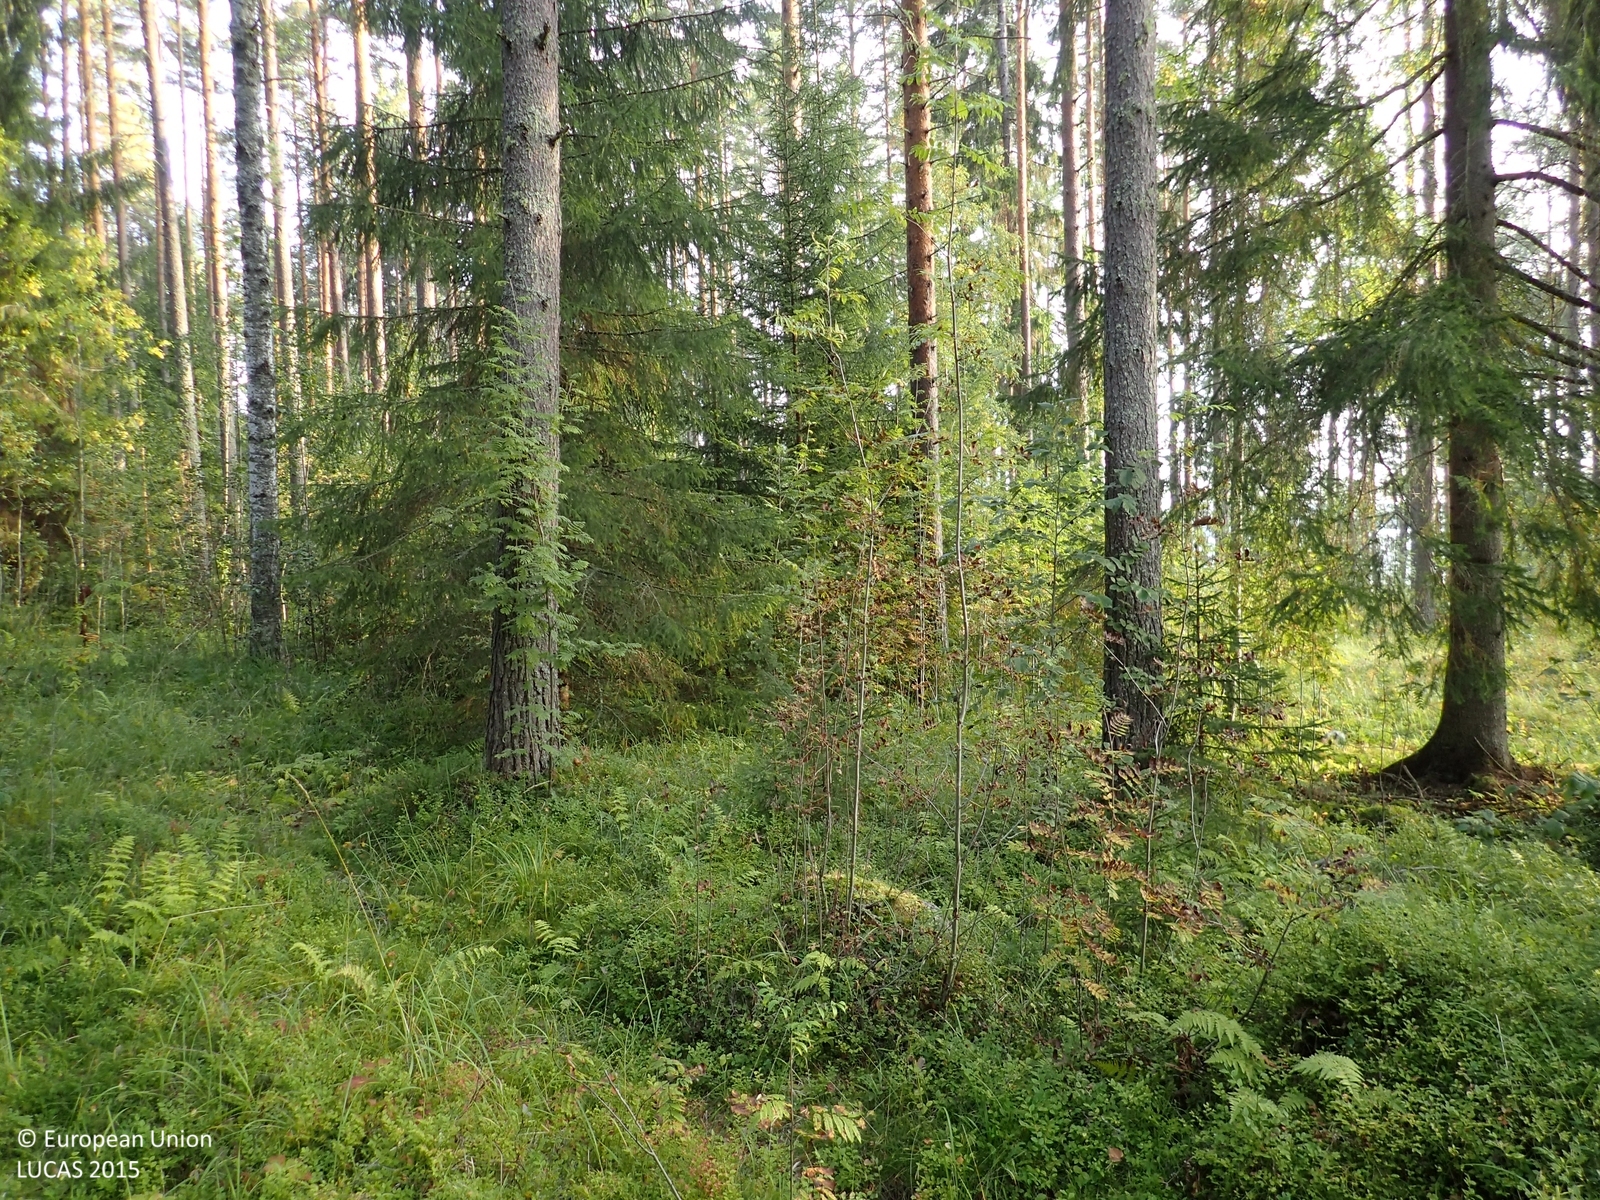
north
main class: Woodland
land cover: Other coniferous woodland
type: boreal forest
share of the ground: > 75 %
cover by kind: coniferous forest trees 70 %, shrubs 20 %, broadleaved forest trees 5 %, herbaceous plants 5 %
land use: Forestry
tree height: > 5 m
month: September
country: FI
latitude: 63.0665
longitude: 25.7653
